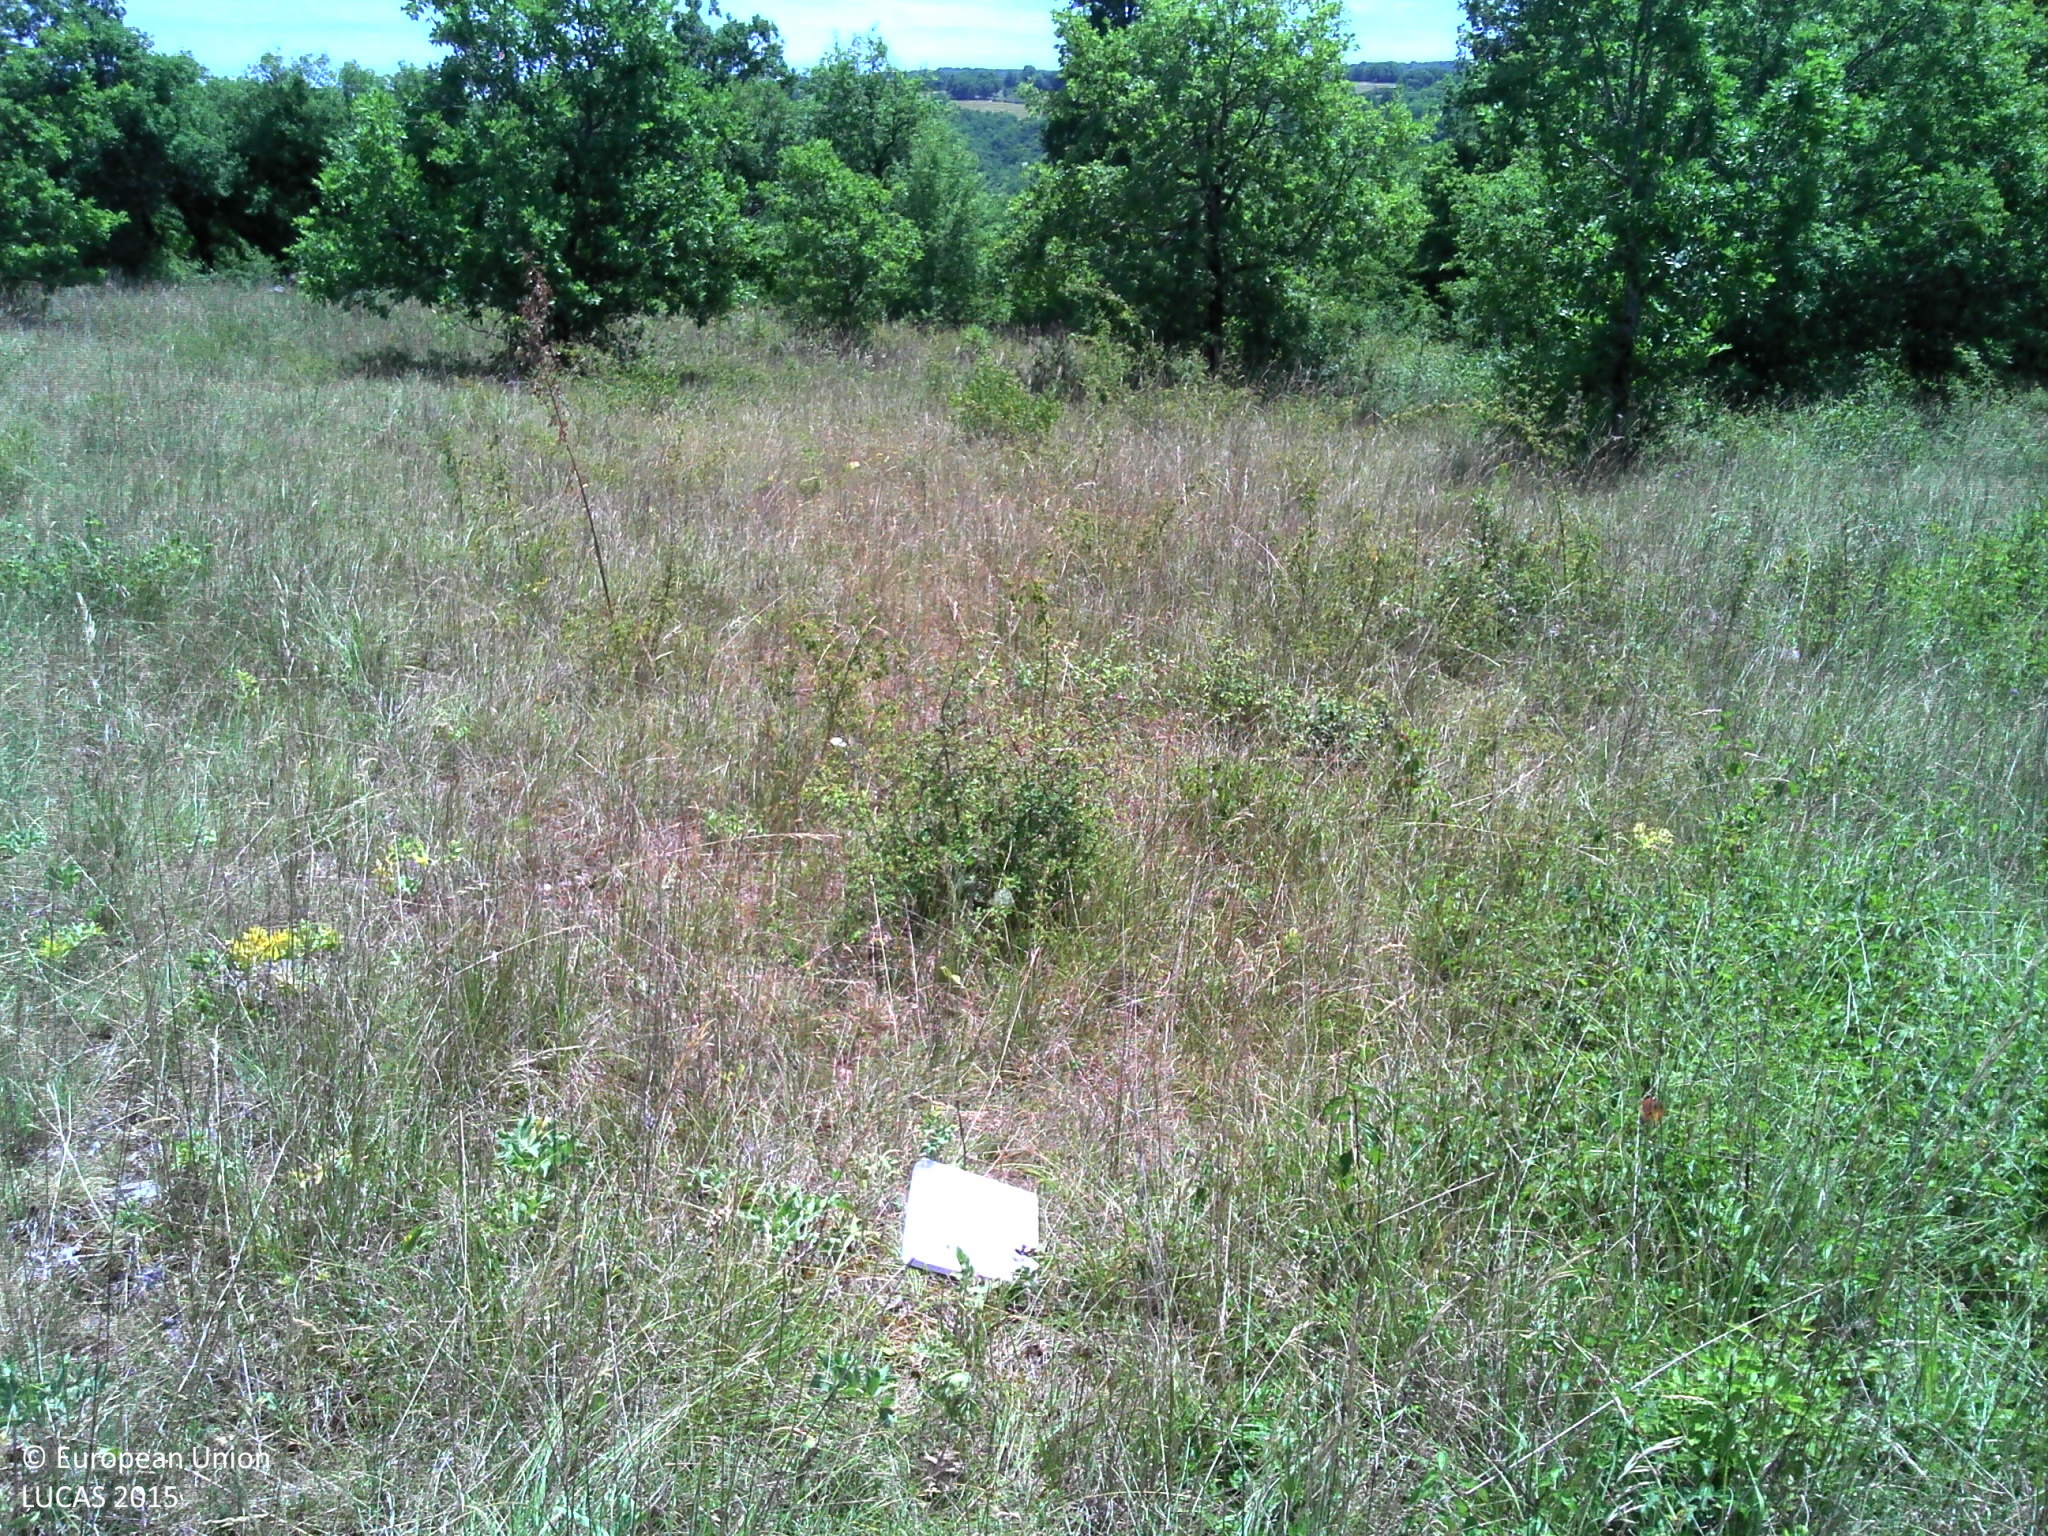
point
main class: Grassland
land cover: Grassland with sparse tree/shrub cover
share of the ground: > 75 %
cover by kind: herbaceous plants 95 %, broadleaved forest trees 5 %
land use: Agriculture (excluding fallow land and kitchen gardens)
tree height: < 5 m
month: June
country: FR
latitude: 44.7365
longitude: 1.6253
